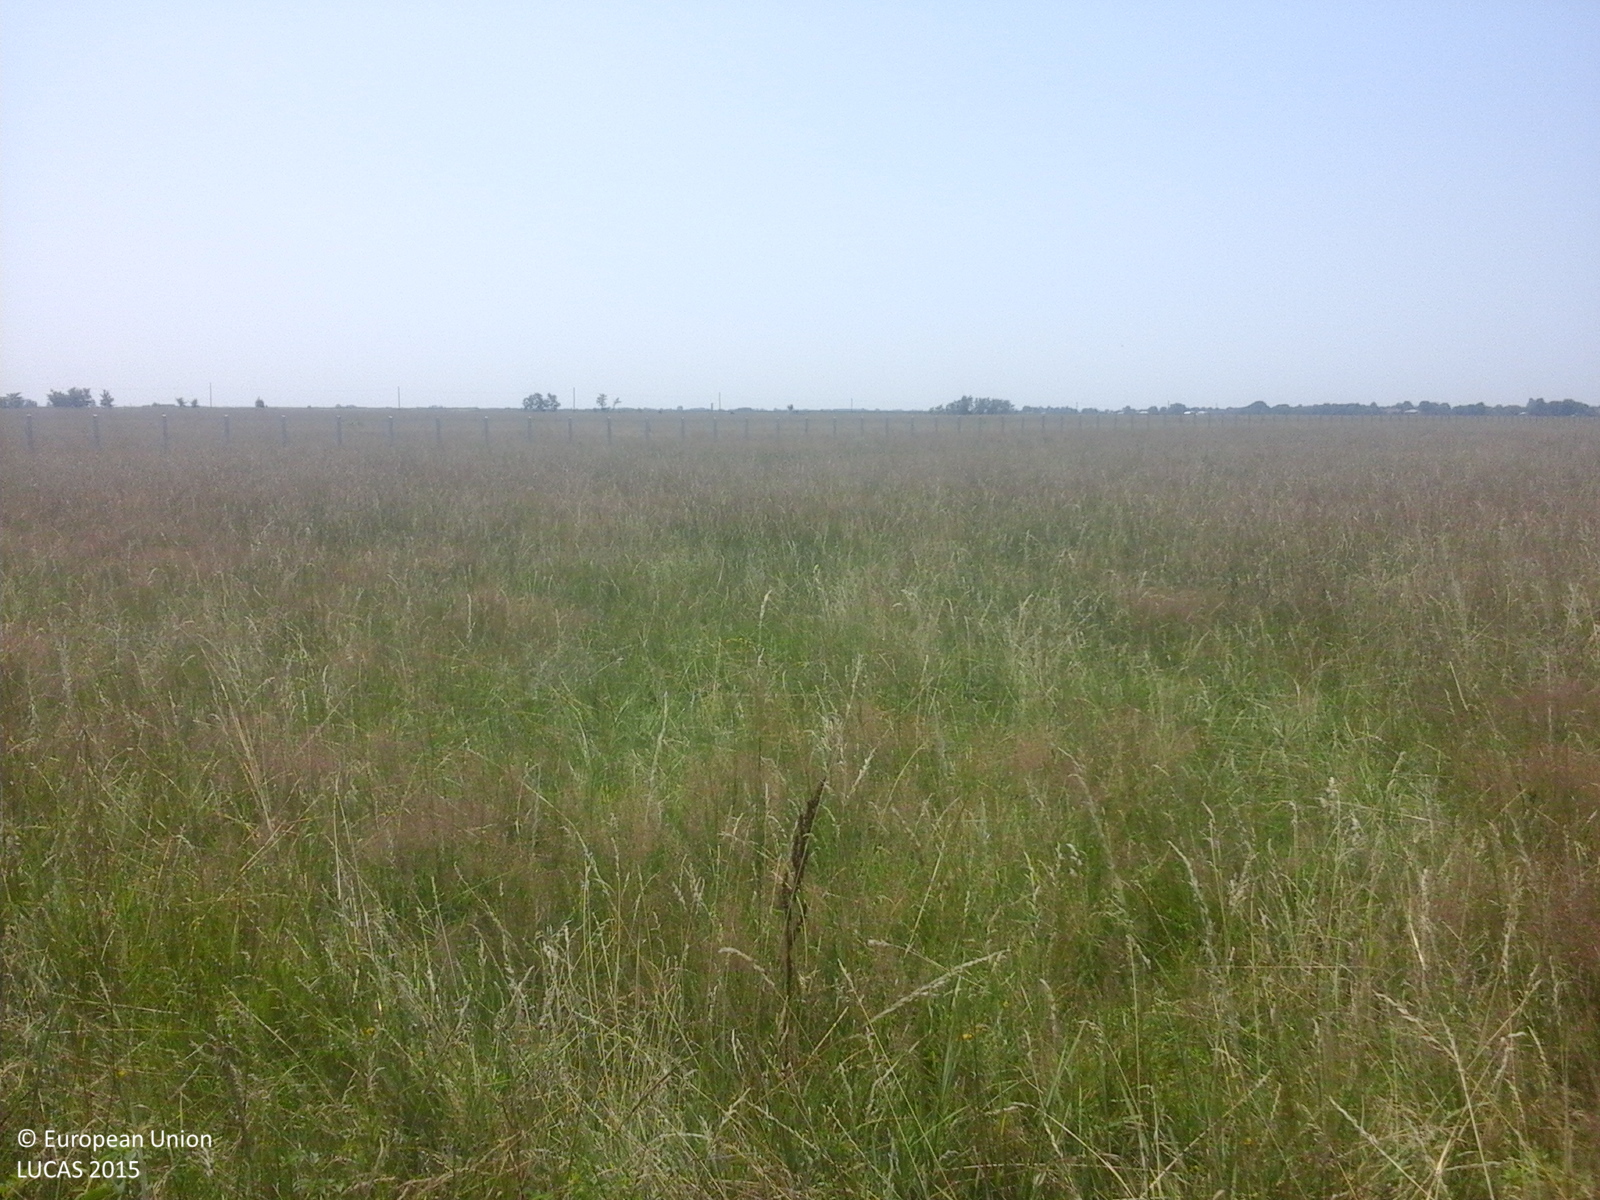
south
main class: Grassland
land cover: Grassland without tree/shrub cover
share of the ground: > 75 %
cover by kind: herbaceous plants 100 %
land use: Agriculture (excluding fallow land and kitchen gardens)
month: July
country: RO
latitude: 44.6982
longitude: 25.0124
